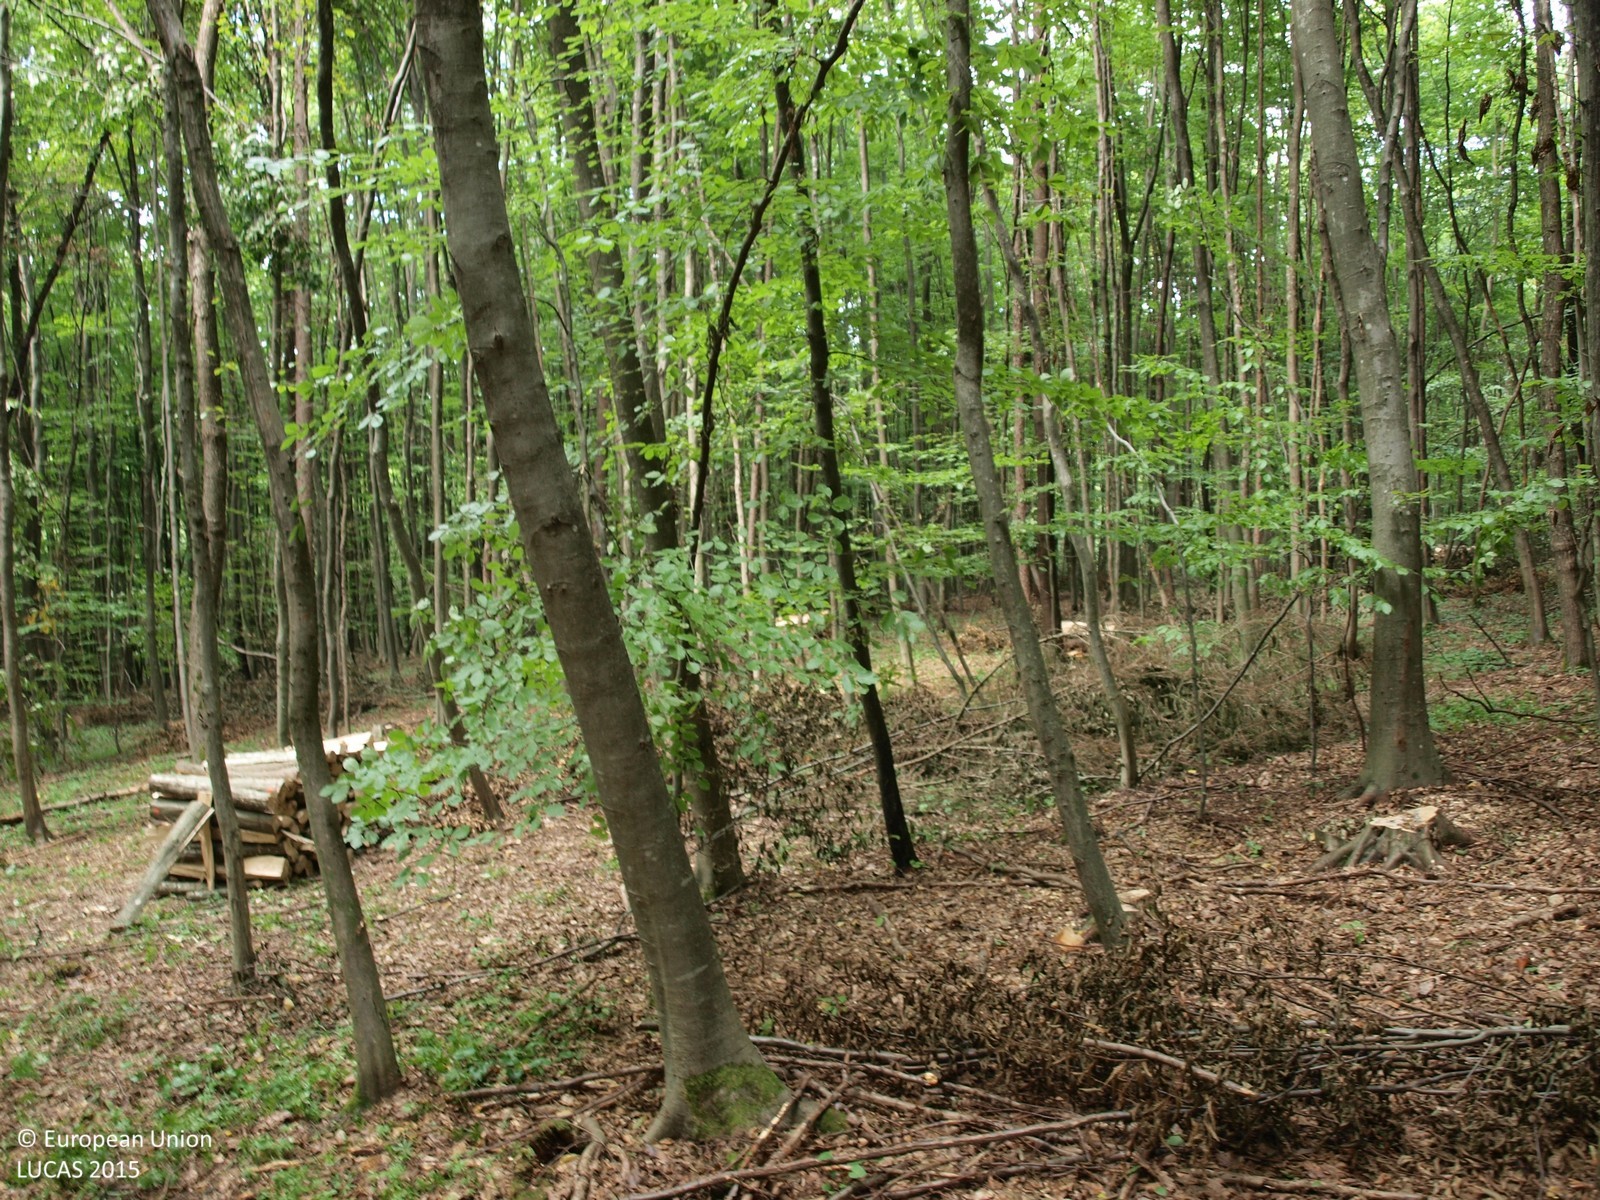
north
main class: Woodland
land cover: Broadleaved woodland
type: beech forest
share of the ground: > 75 %
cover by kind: broadleaved forest trees 100 %
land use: Forestry
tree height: > 5 m
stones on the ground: < 10 %
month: August
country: HR
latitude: 46.0028
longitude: 16.5986
